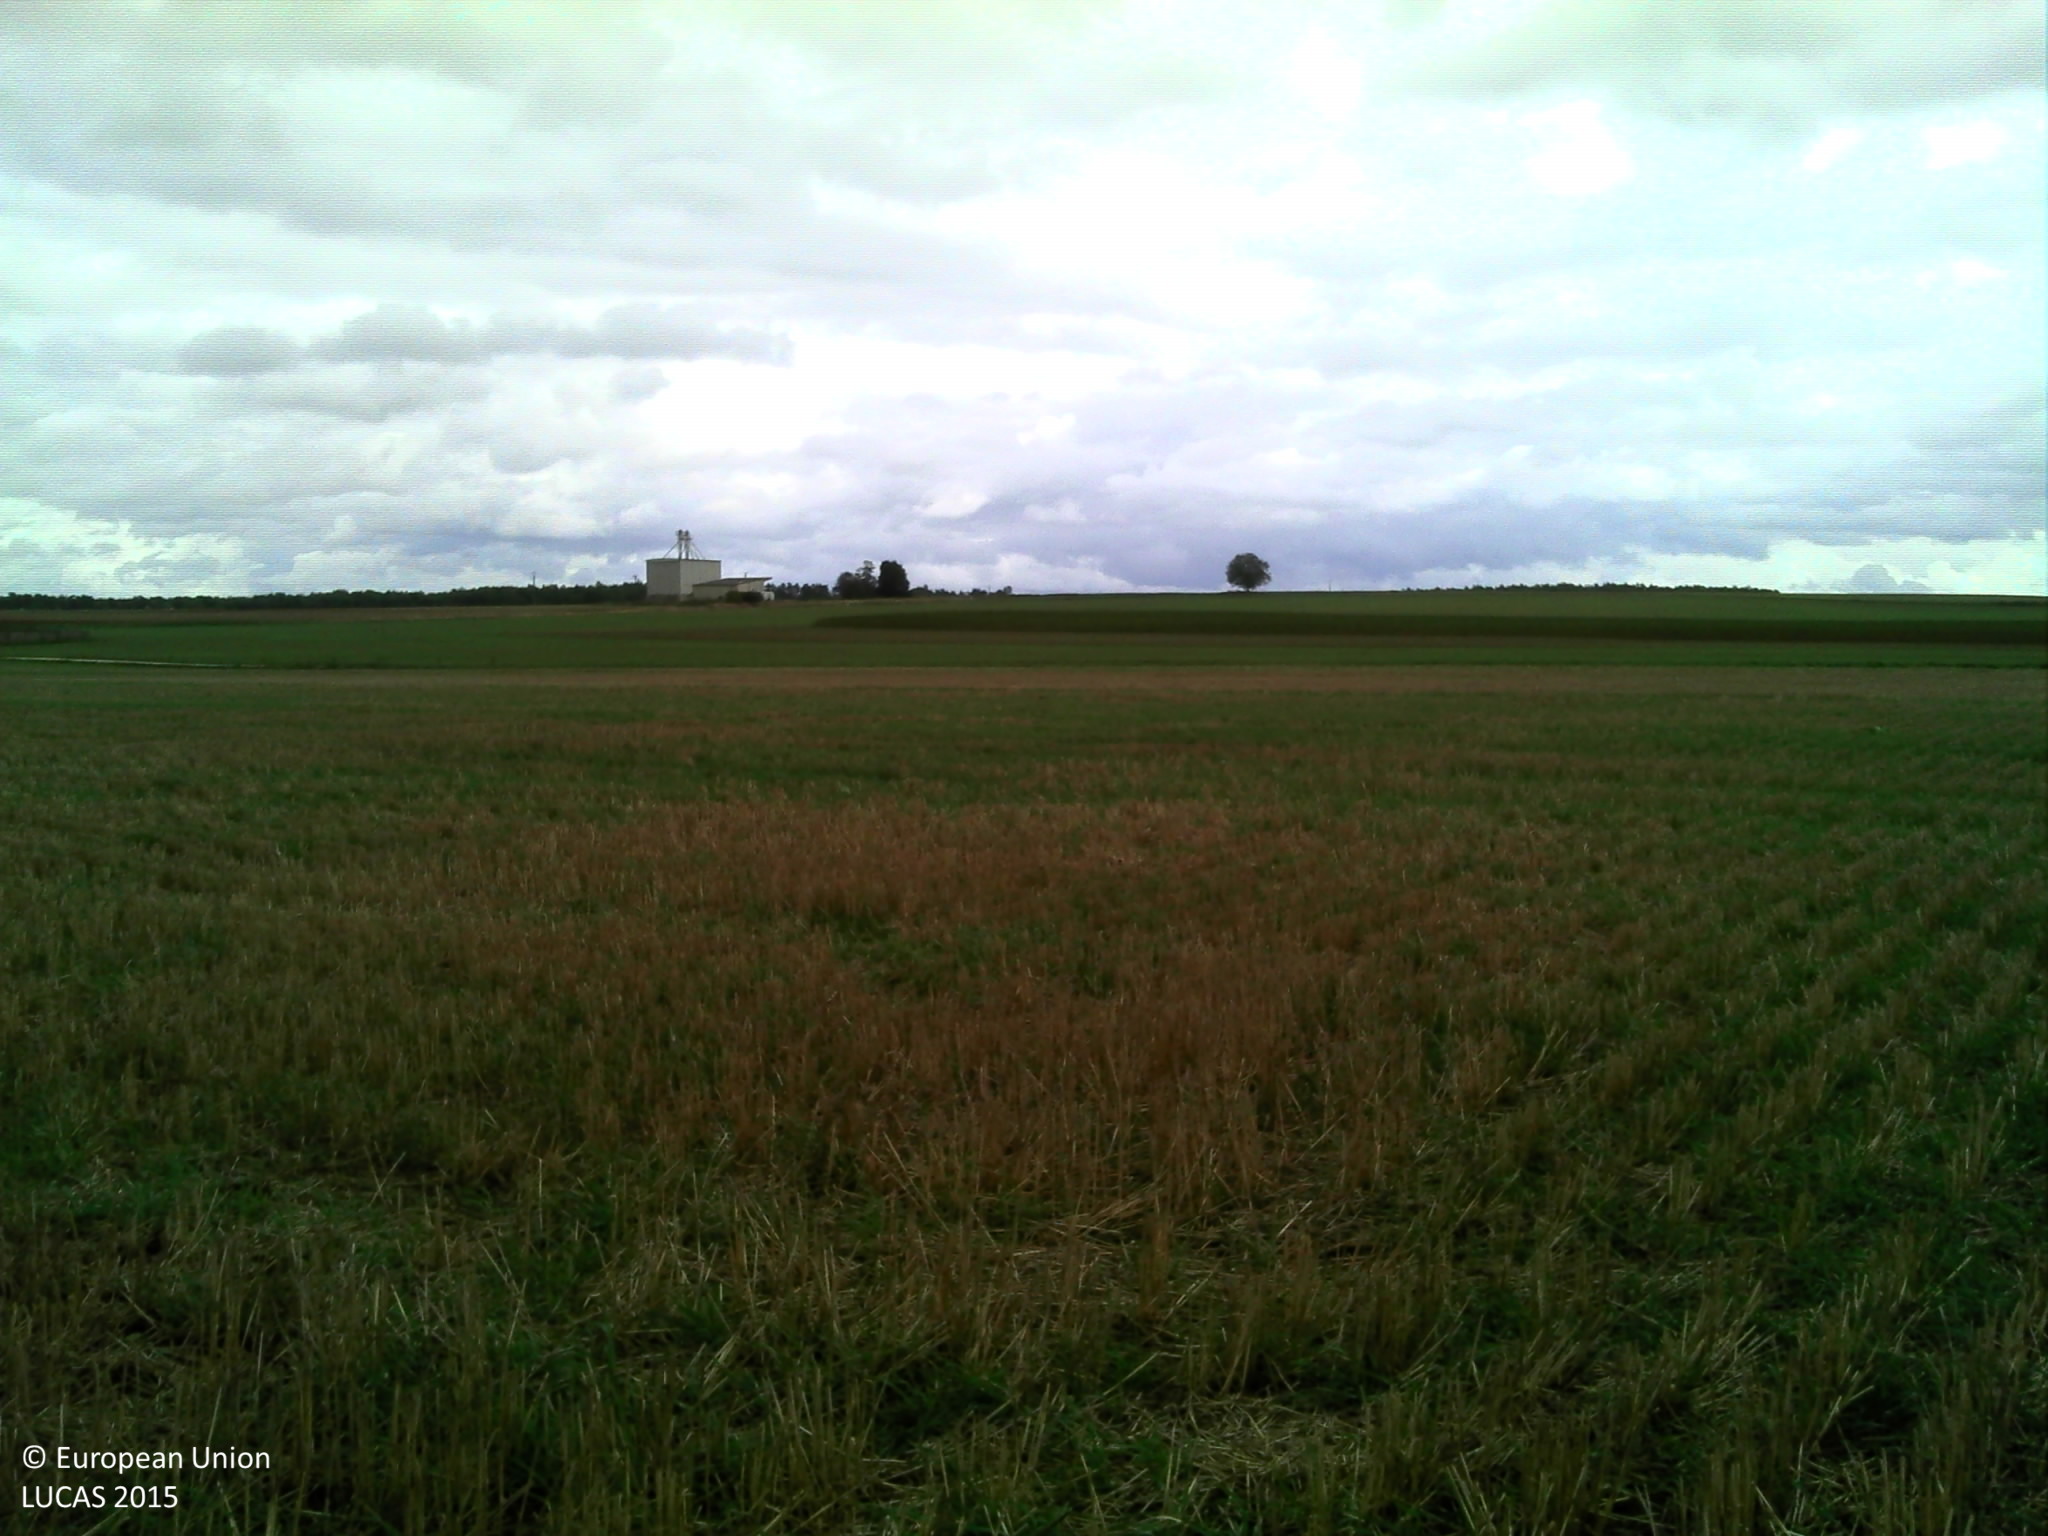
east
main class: Cropland
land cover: Common wheat
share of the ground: 25 - 50 %
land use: Agriculture (excluding fallow land and kitchen gardens)
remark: Harvested field
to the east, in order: Common wheat; Grass margins; Tracks; Grass margins; Other bare soil
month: September
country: FR
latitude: 47.7142
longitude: 4.2798
